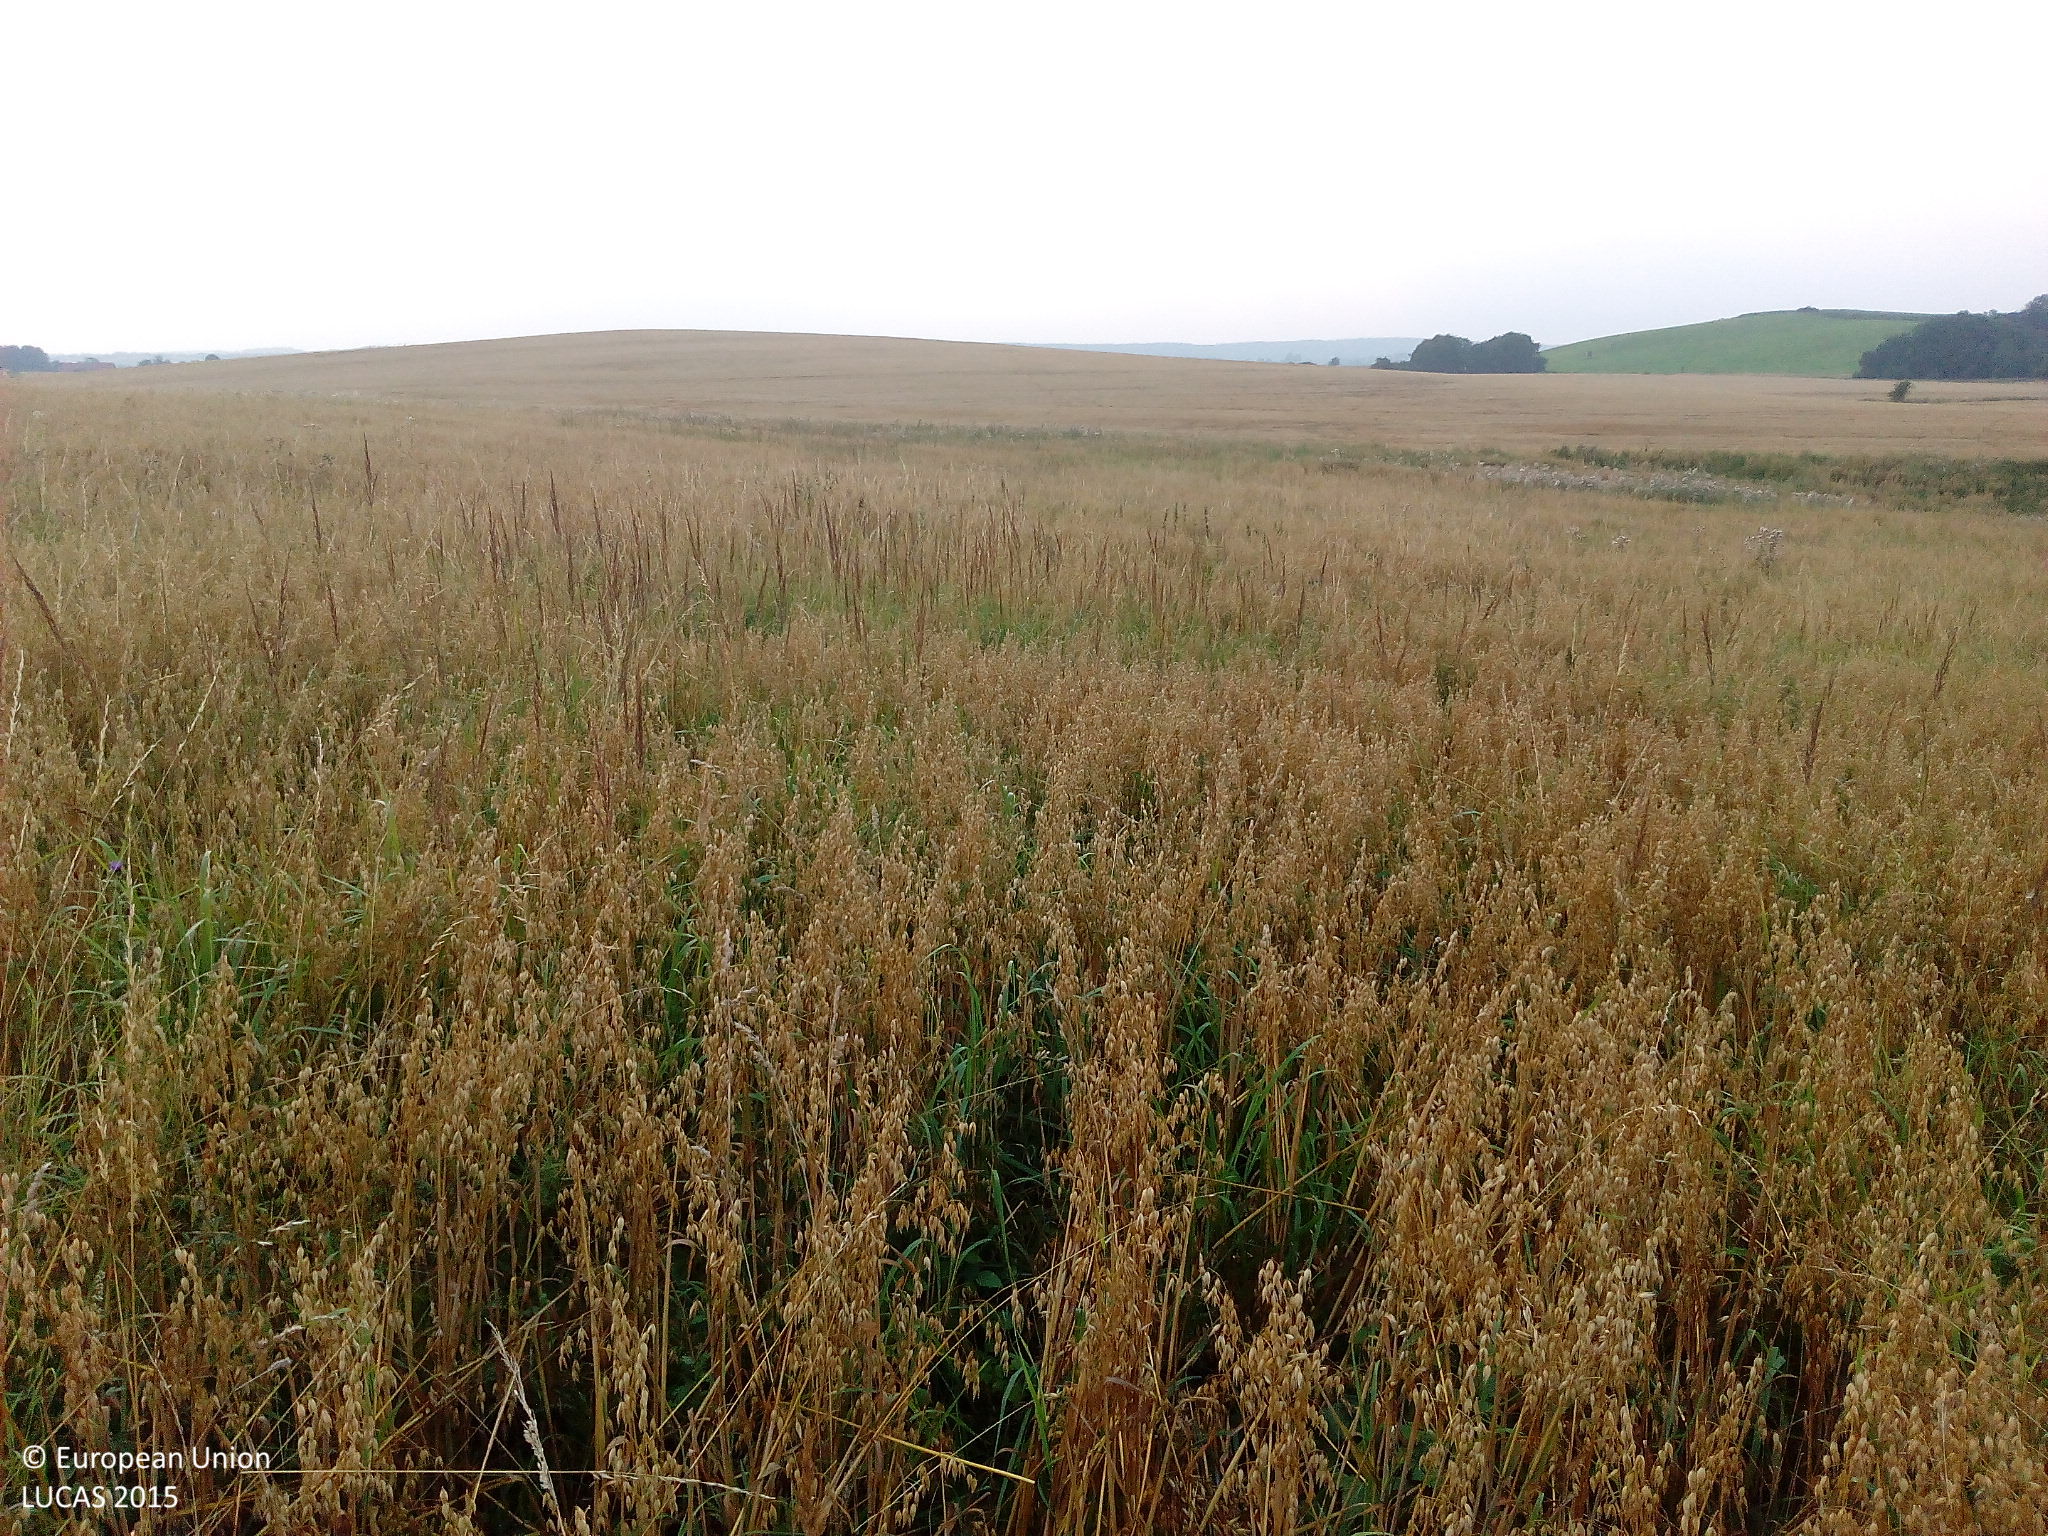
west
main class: Cropland
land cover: Oats
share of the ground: > 75 %
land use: Agriculture (excluding fallow land and kitchen gardens)
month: August
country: DE
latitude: 53.7214
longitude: 12.3178
